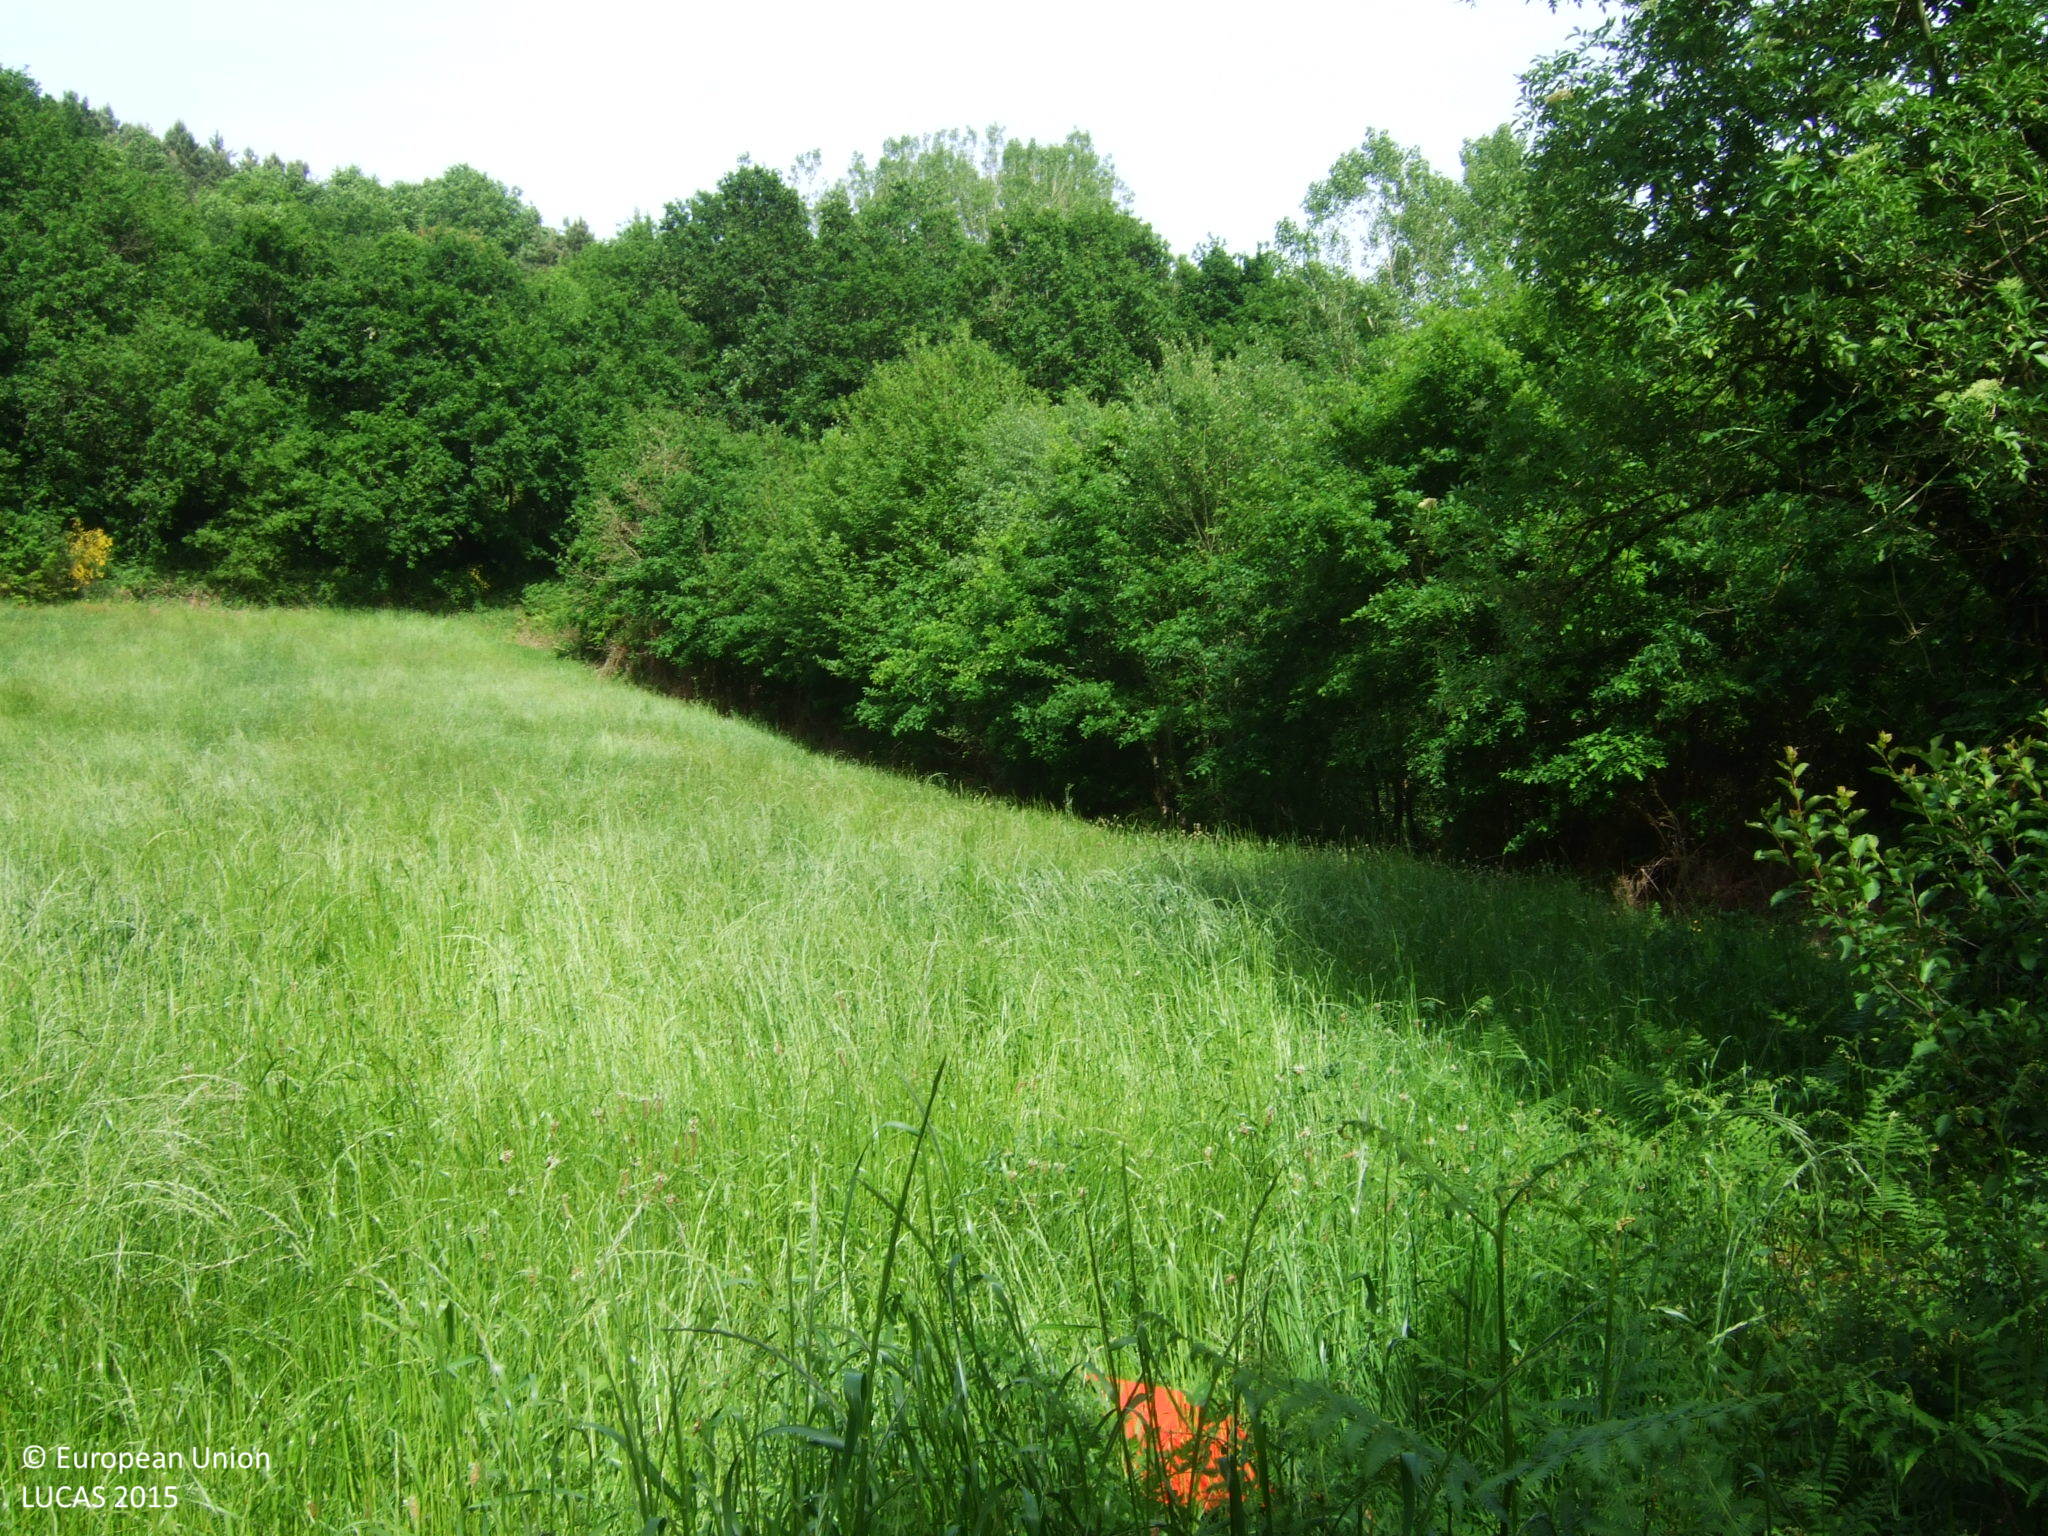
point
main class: Grassland
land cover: Grassland without tree/shrub cover
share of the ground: > 75 %
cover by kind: herbaceous plants 100 %
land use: Agriculture (excluding fallow land and kitchen gardens)
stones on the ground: < 10 %
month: May
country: ES
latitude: 42.8672
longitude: -7.2904
